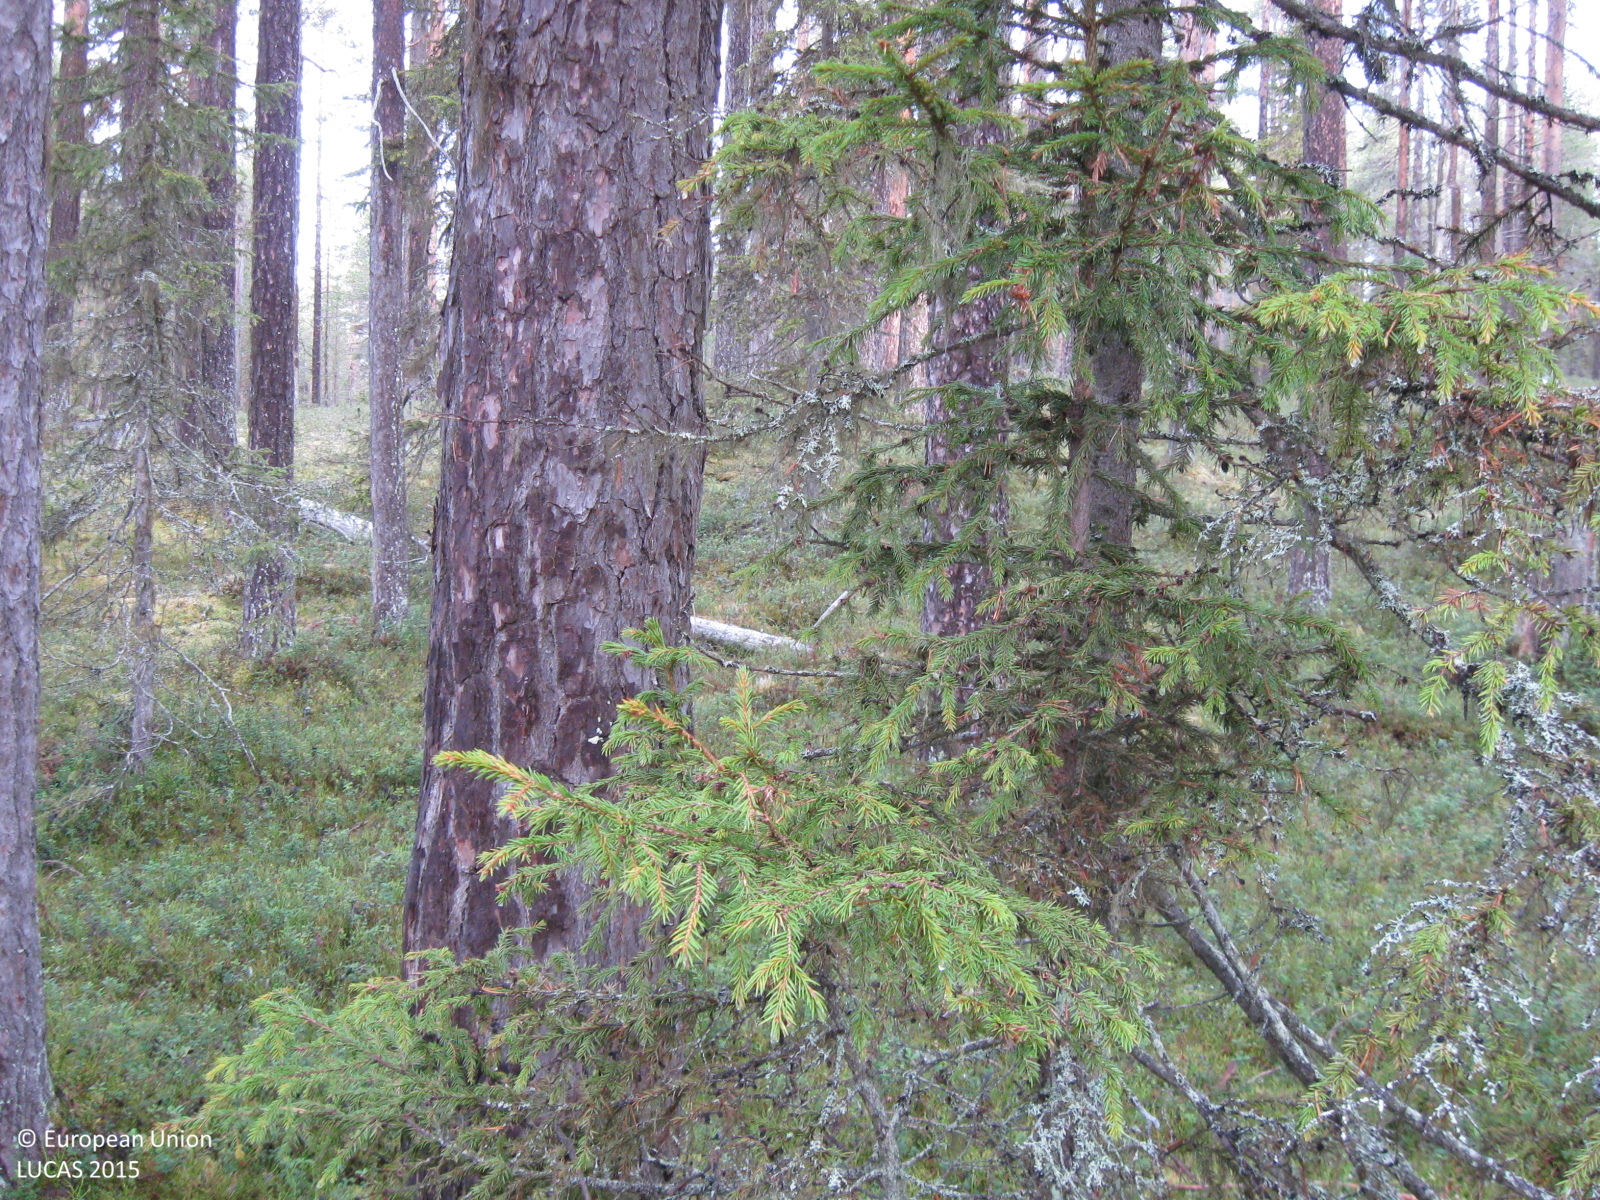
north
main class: Woodland
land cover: Pine dominated coniferous woodland
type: boreal forest
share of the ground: 50 - 75 %
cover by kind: coniferous forest trees 70 %, shrubs 15 %, lichens and mosses 10 %, herbaceous plants 5 %
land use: Forestry
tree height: > 5 m
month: October
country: SE
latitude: 66.4134
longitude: 20.9564
